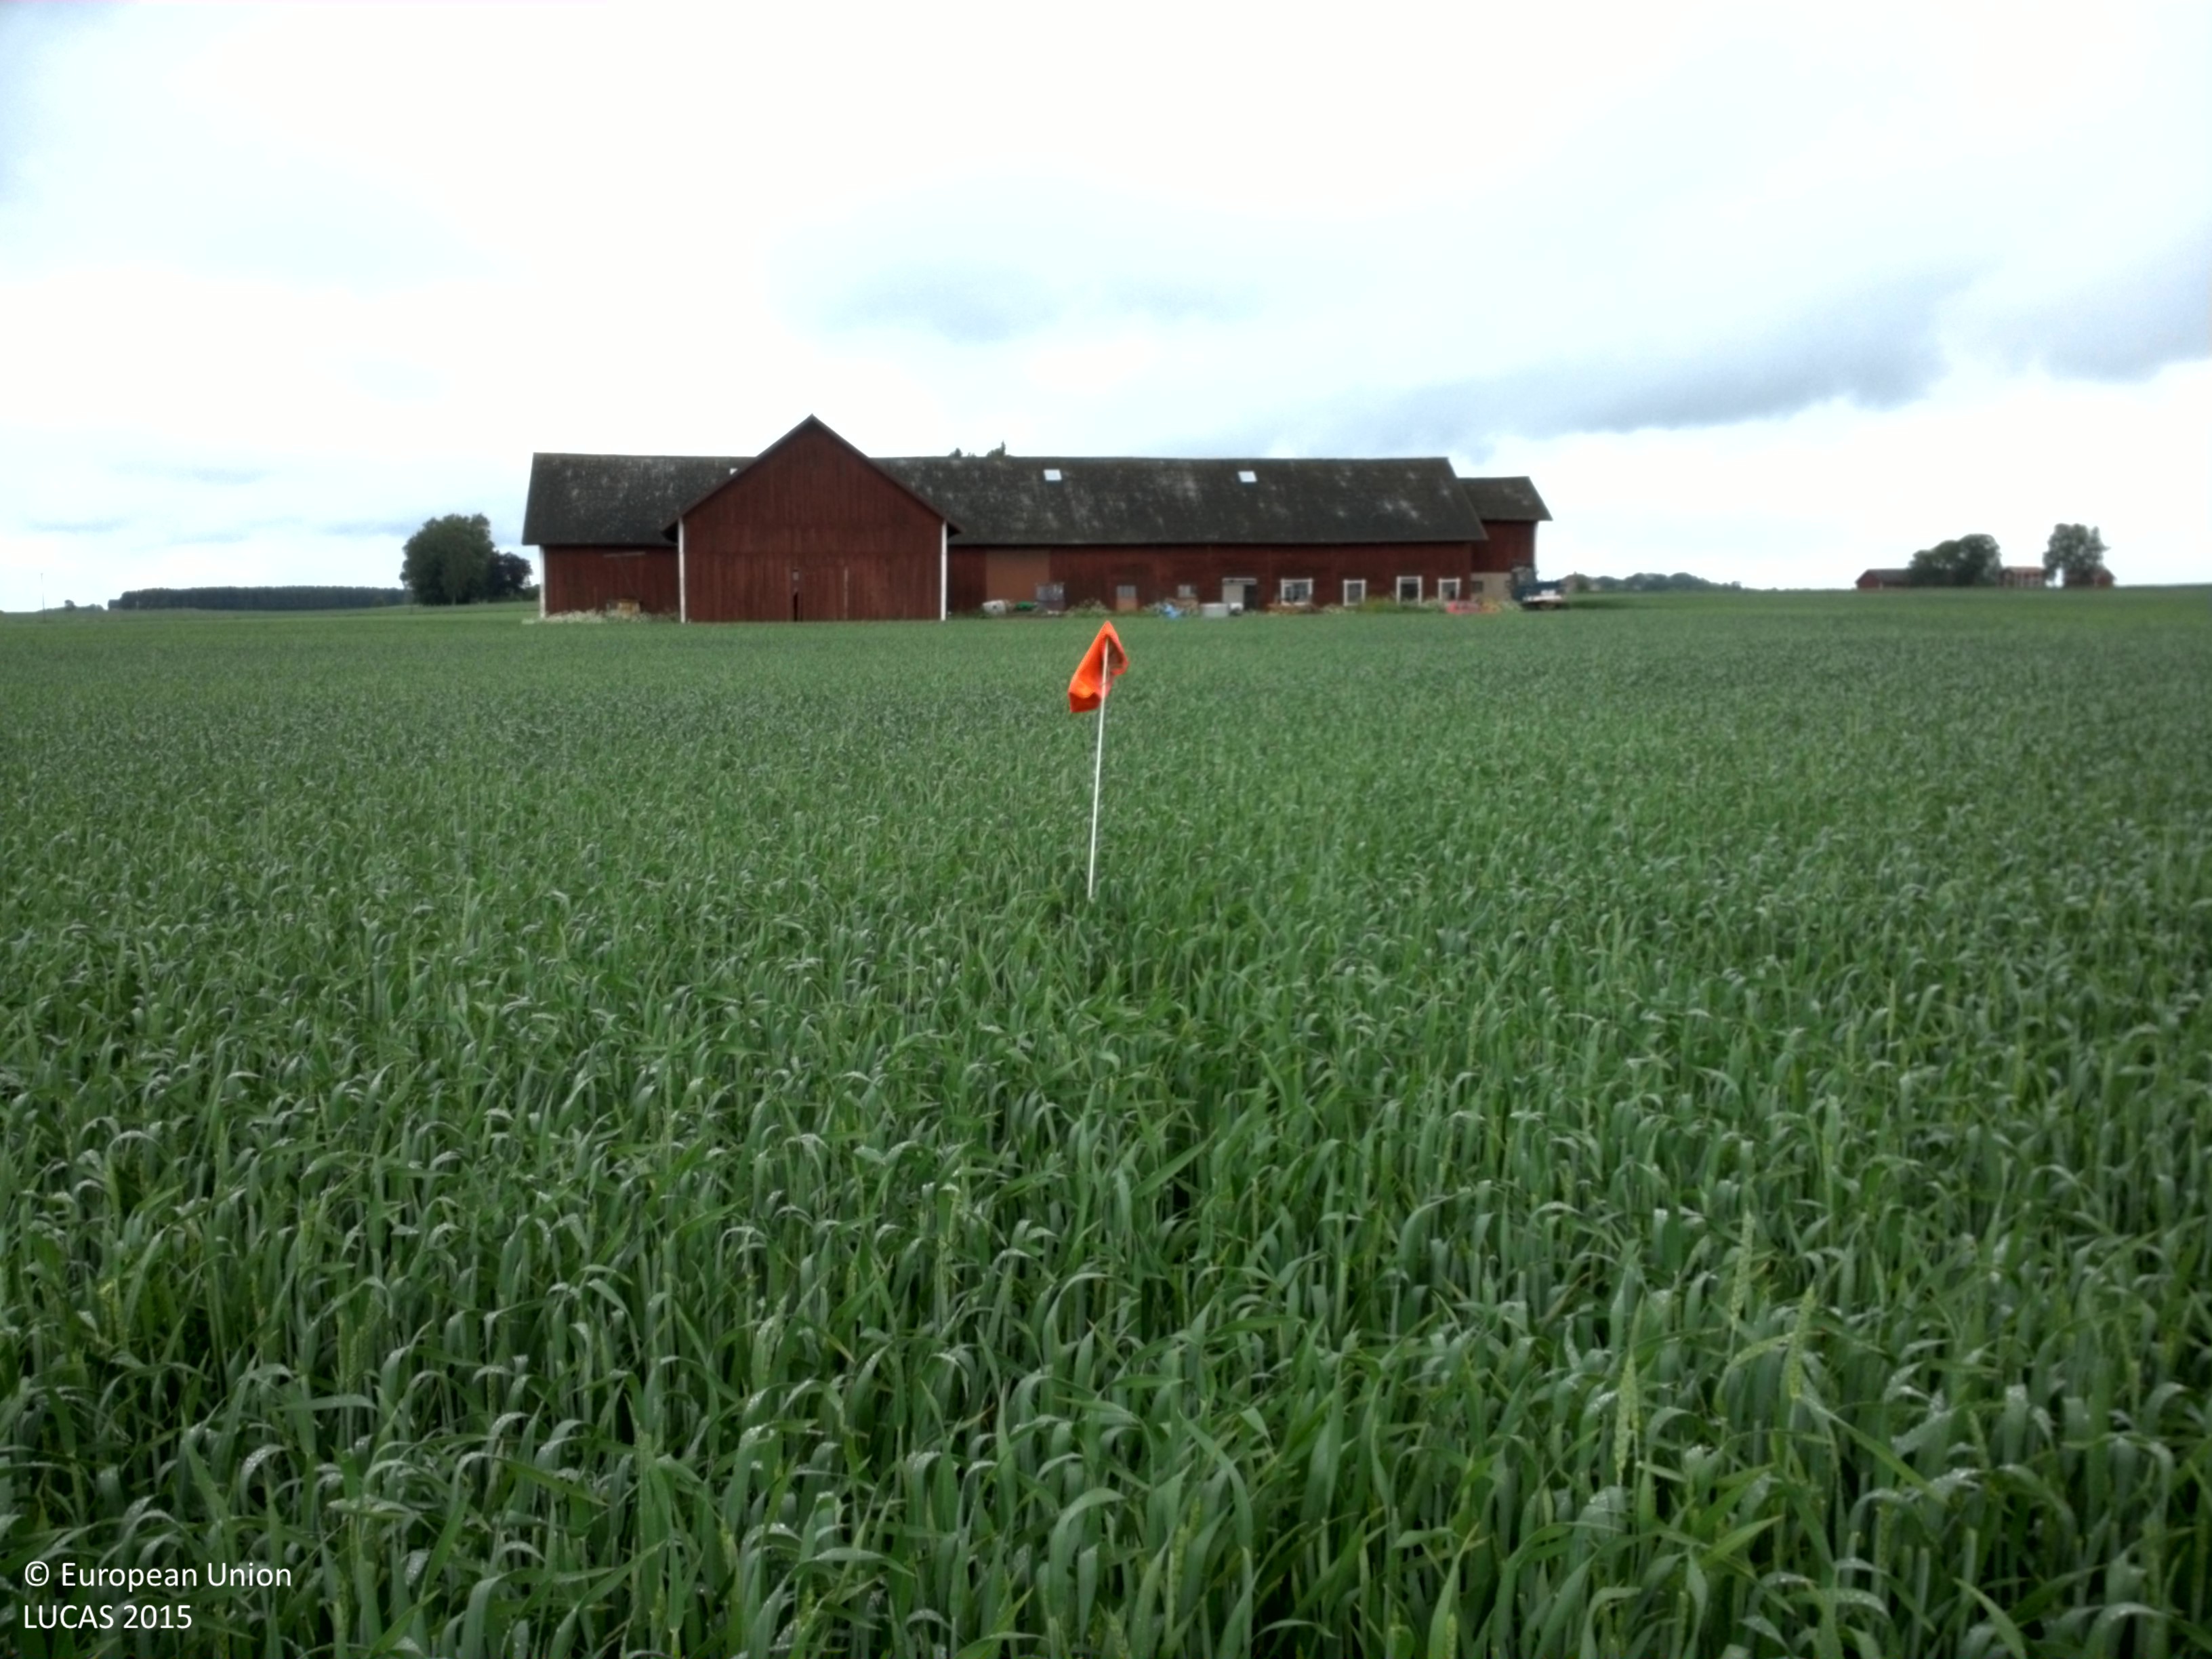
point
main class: Cropland
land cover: Common wheat
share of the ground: > 75 %
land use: Agriculture (excluding fallow land and kitchen gardens)
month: June
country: SE
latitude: 58.4401
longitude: 15.2873
